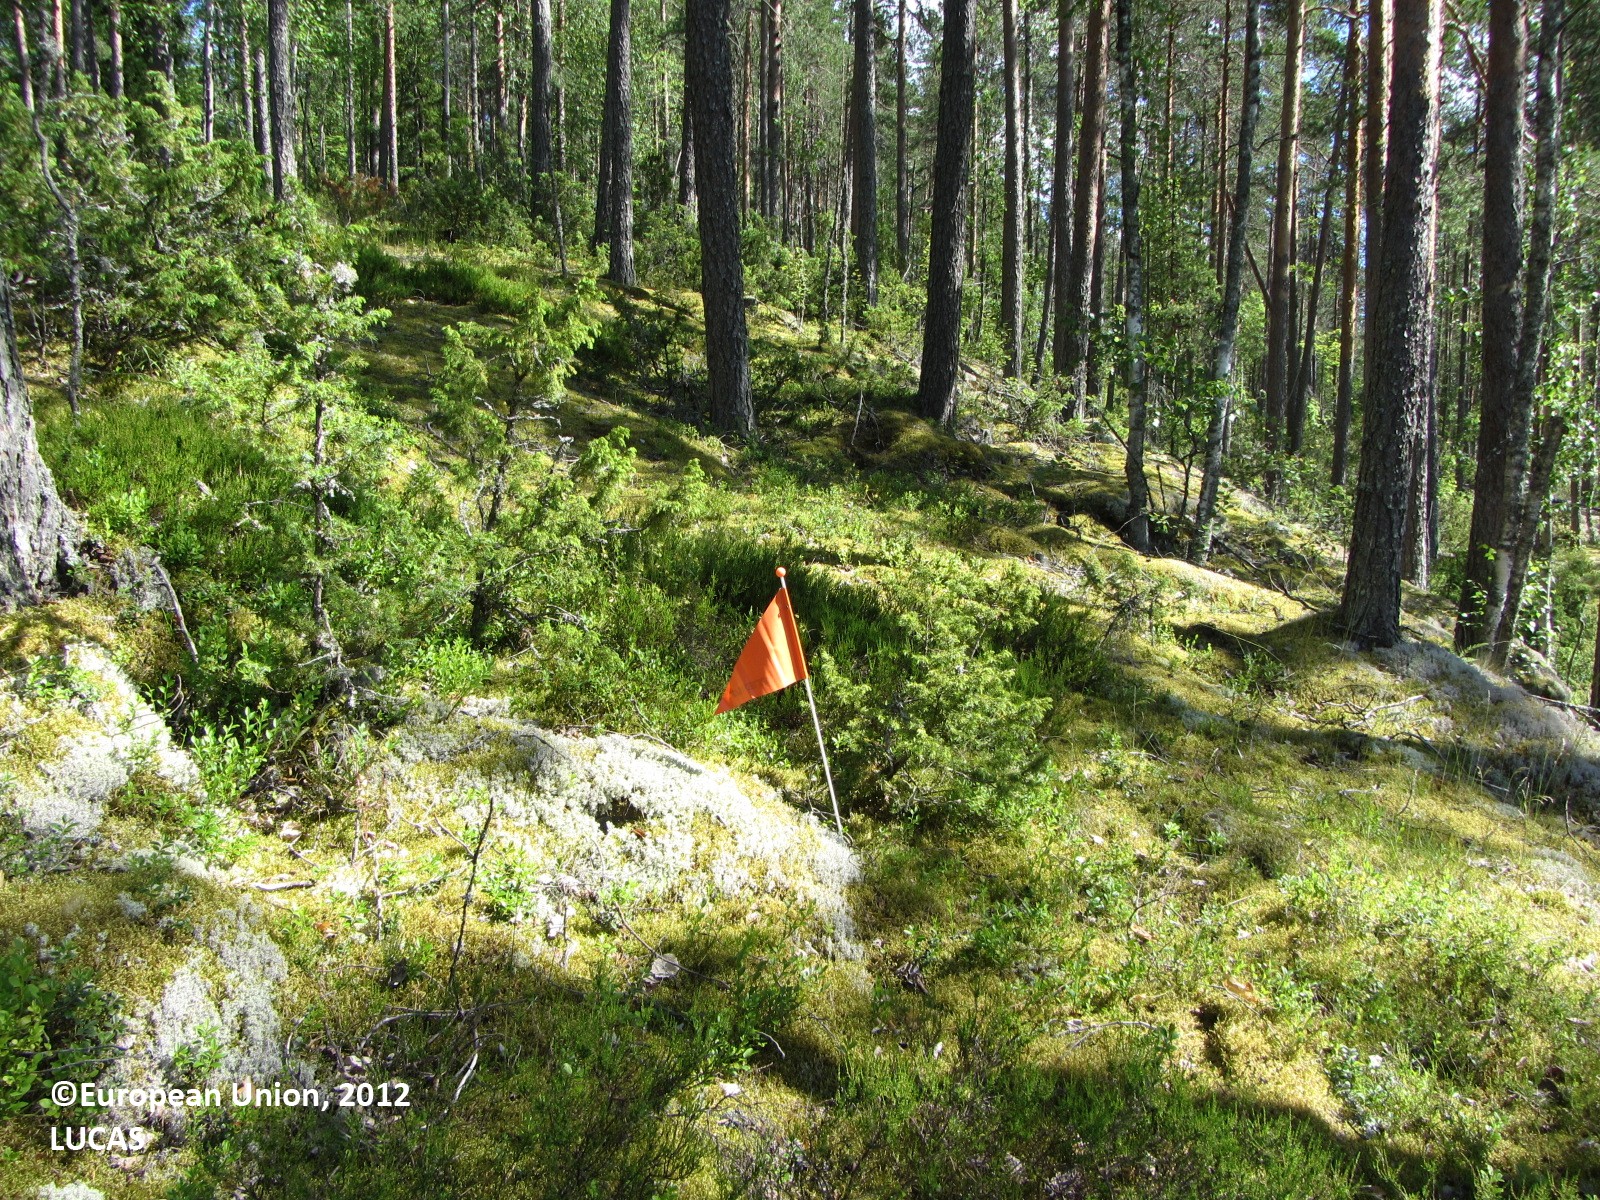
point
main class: Woodland
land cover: Pine dominated coniferous woodland
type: boreal forest
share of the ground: > 75 %
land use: Forestry
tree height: > 5 m
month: July
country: FI
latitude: 63.0650
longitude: 25.6022
